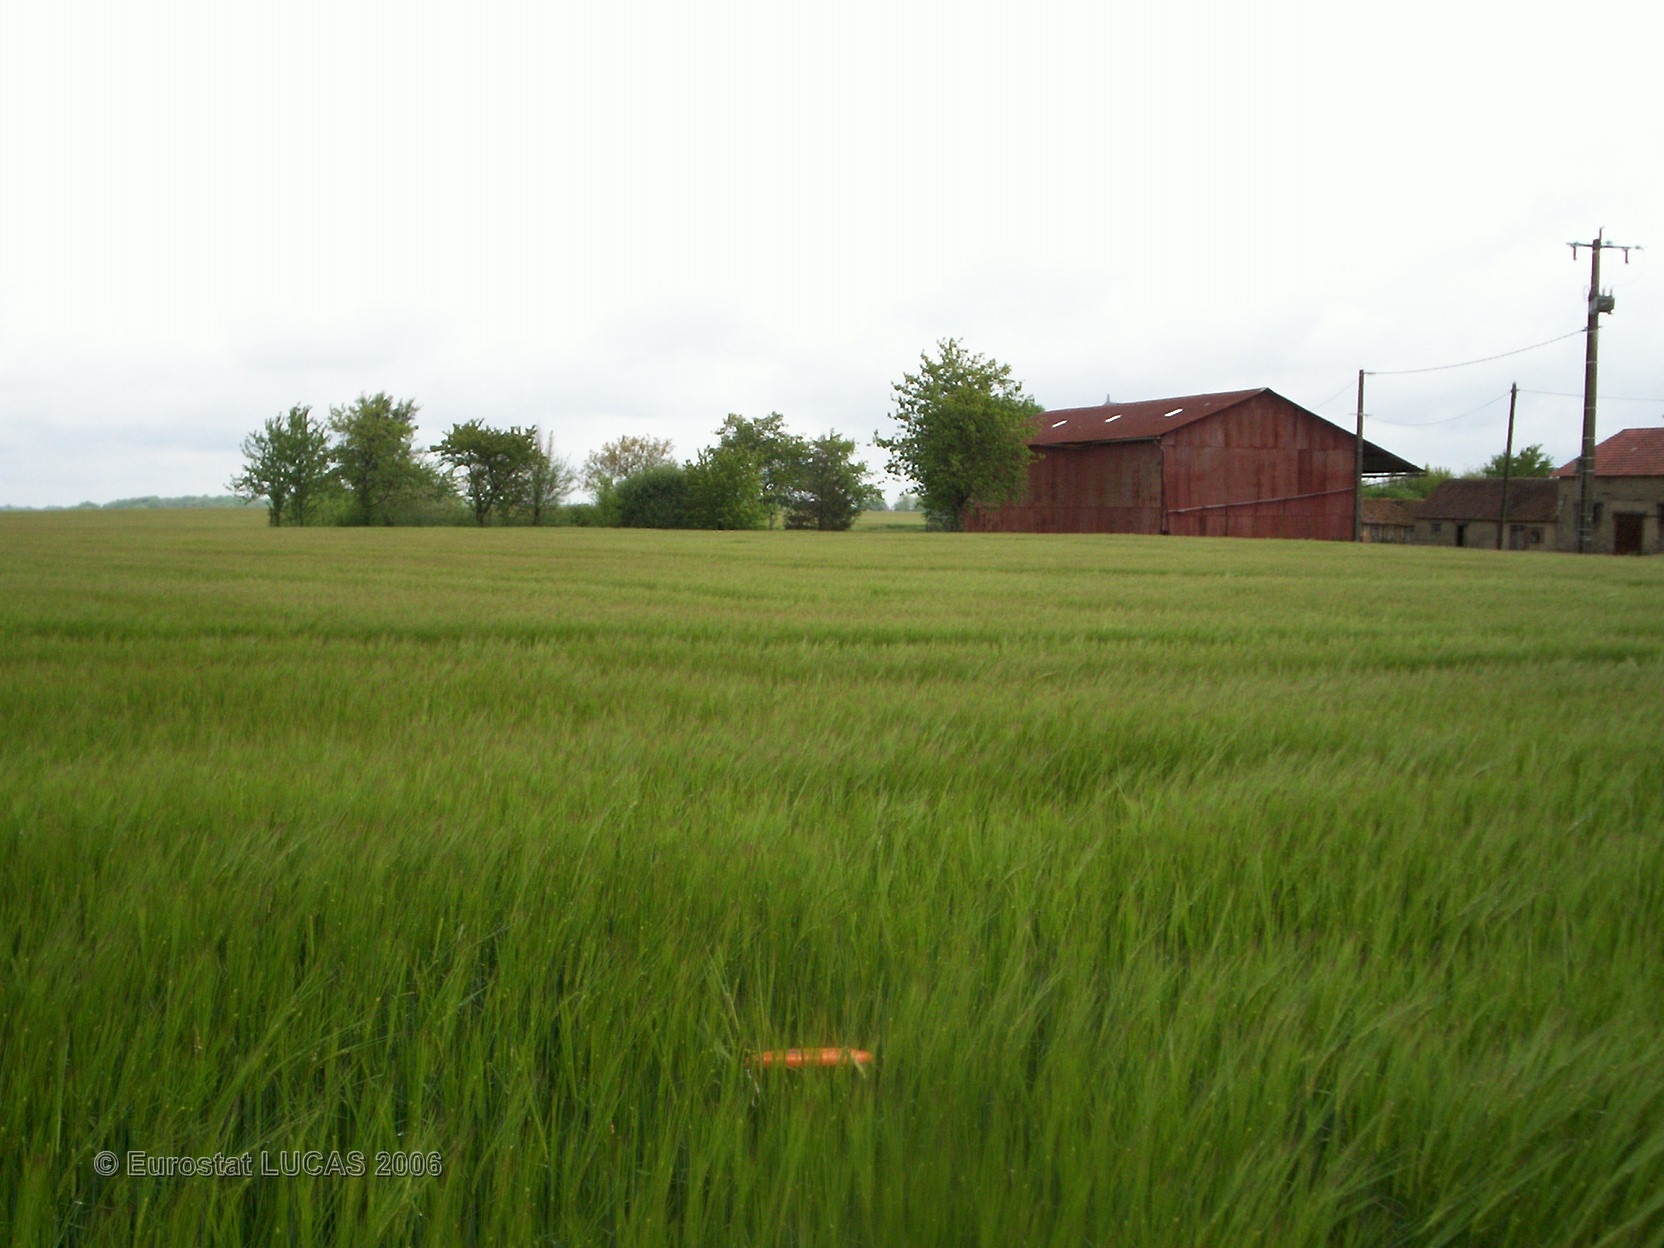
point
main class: Cropland
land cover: Barley
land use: Agriculture (excluding fallow land and kitchen gardens)
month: May
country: FR
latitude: 47.9982
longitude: 2.9566
